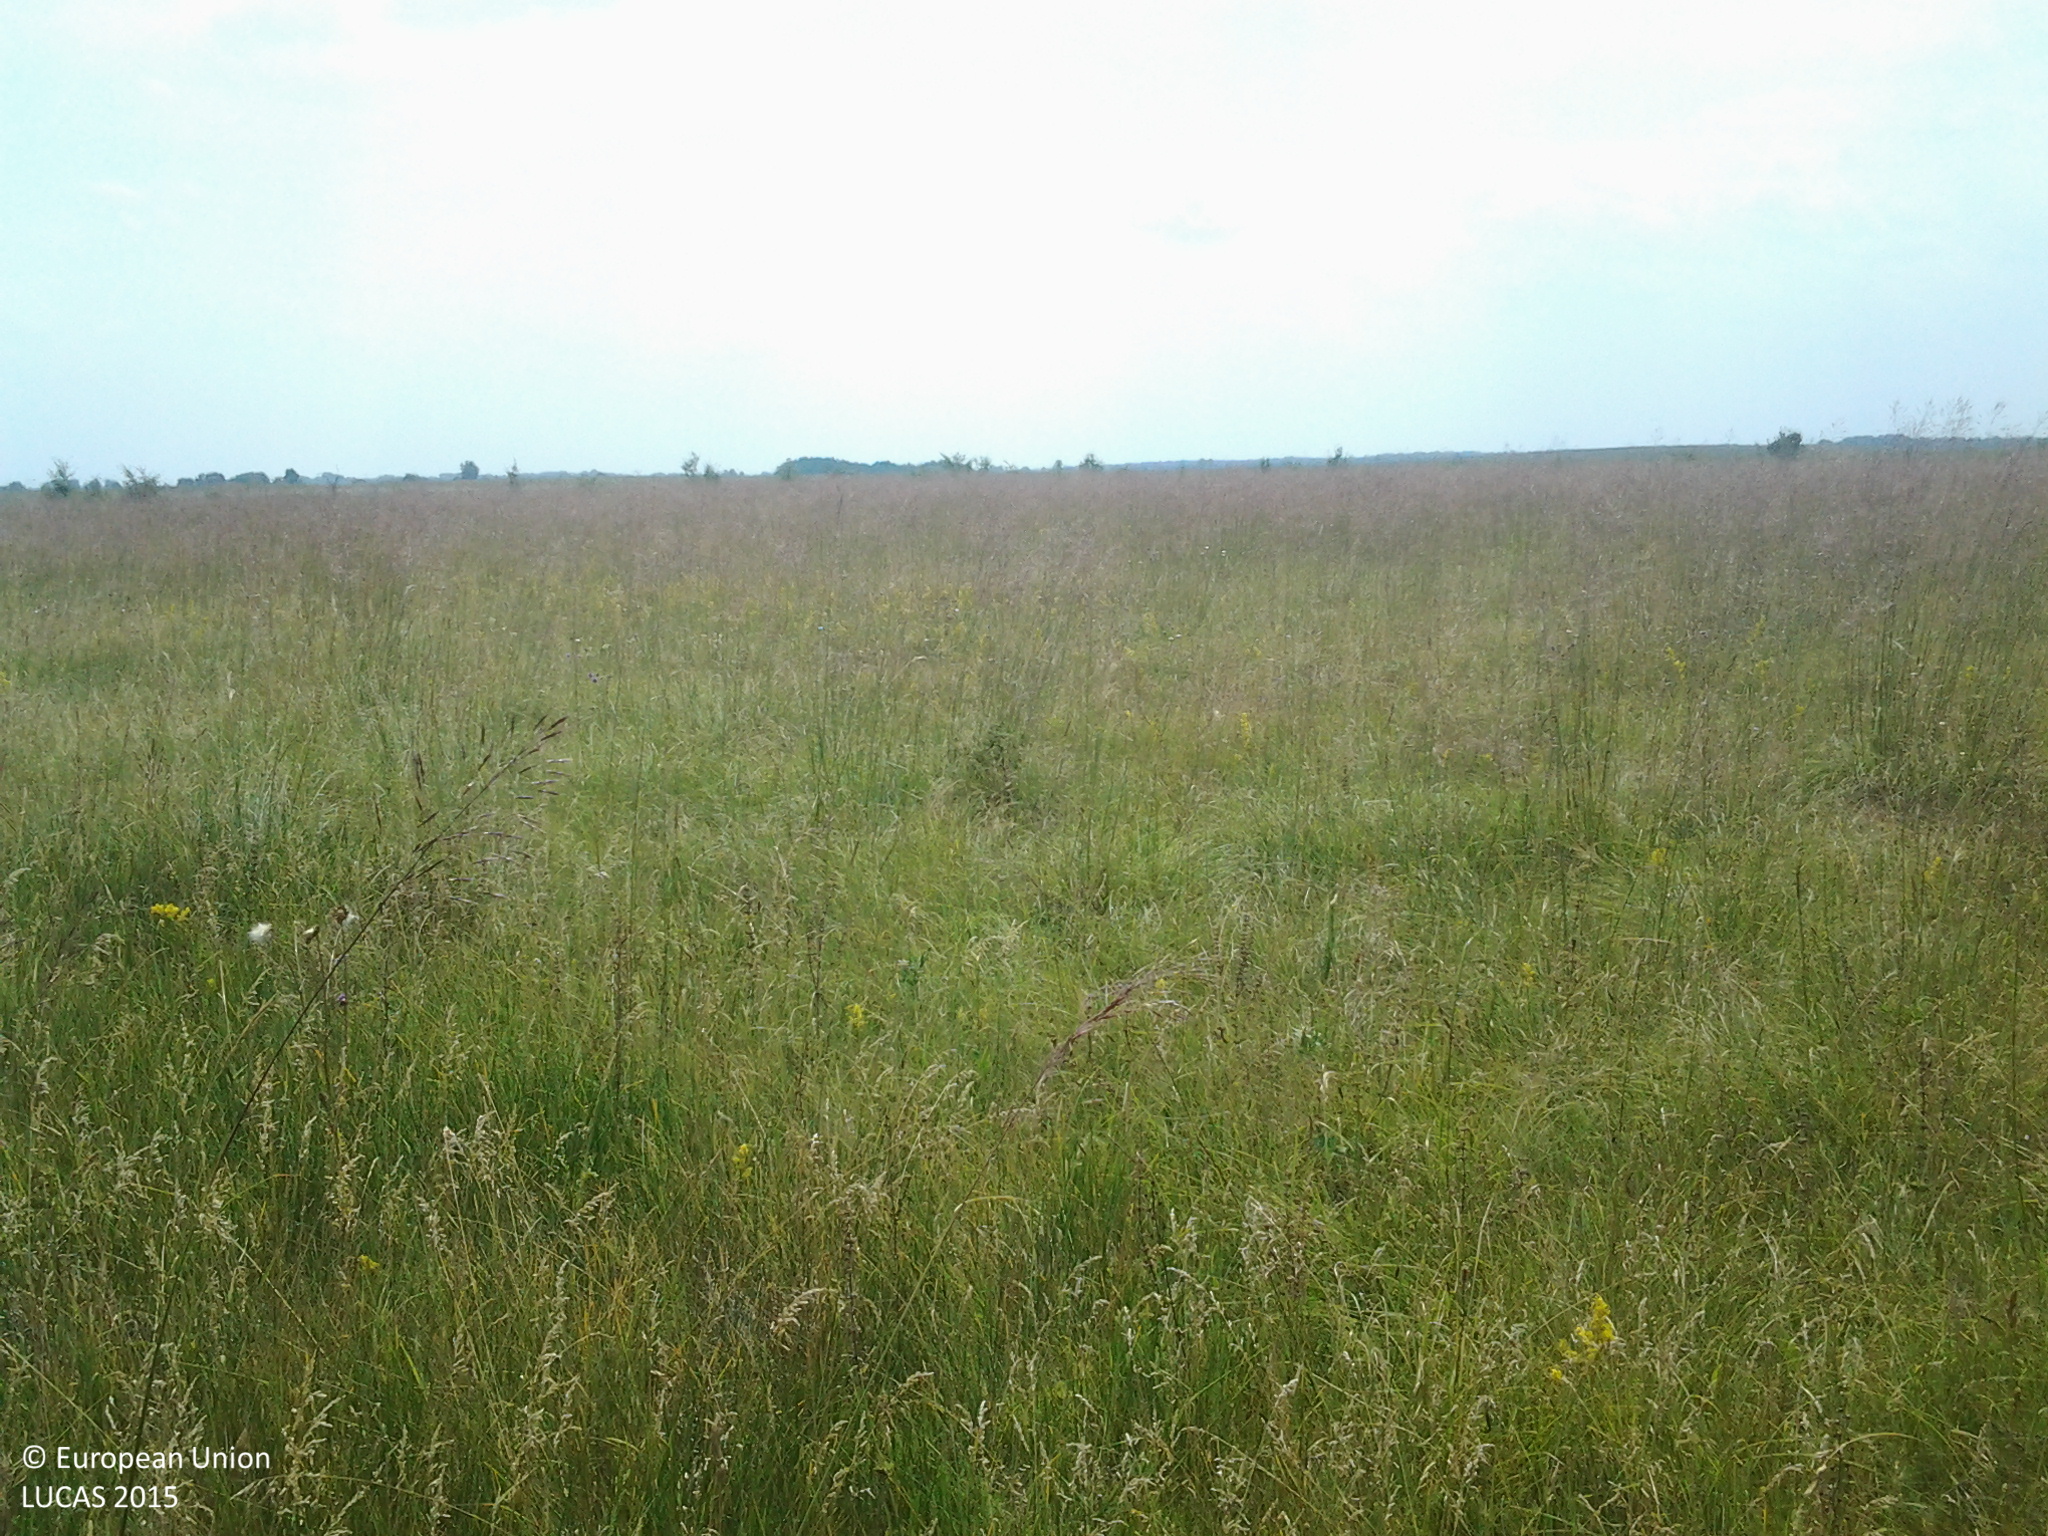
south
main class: Grassland
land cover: Grassland without tree/shrub cover
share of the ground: > 75 %
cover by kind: herbaceous plants 100 %
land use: Semi-natural and natural areas not in use
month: July
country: HU
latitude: 47.1089
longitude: 19.2556
